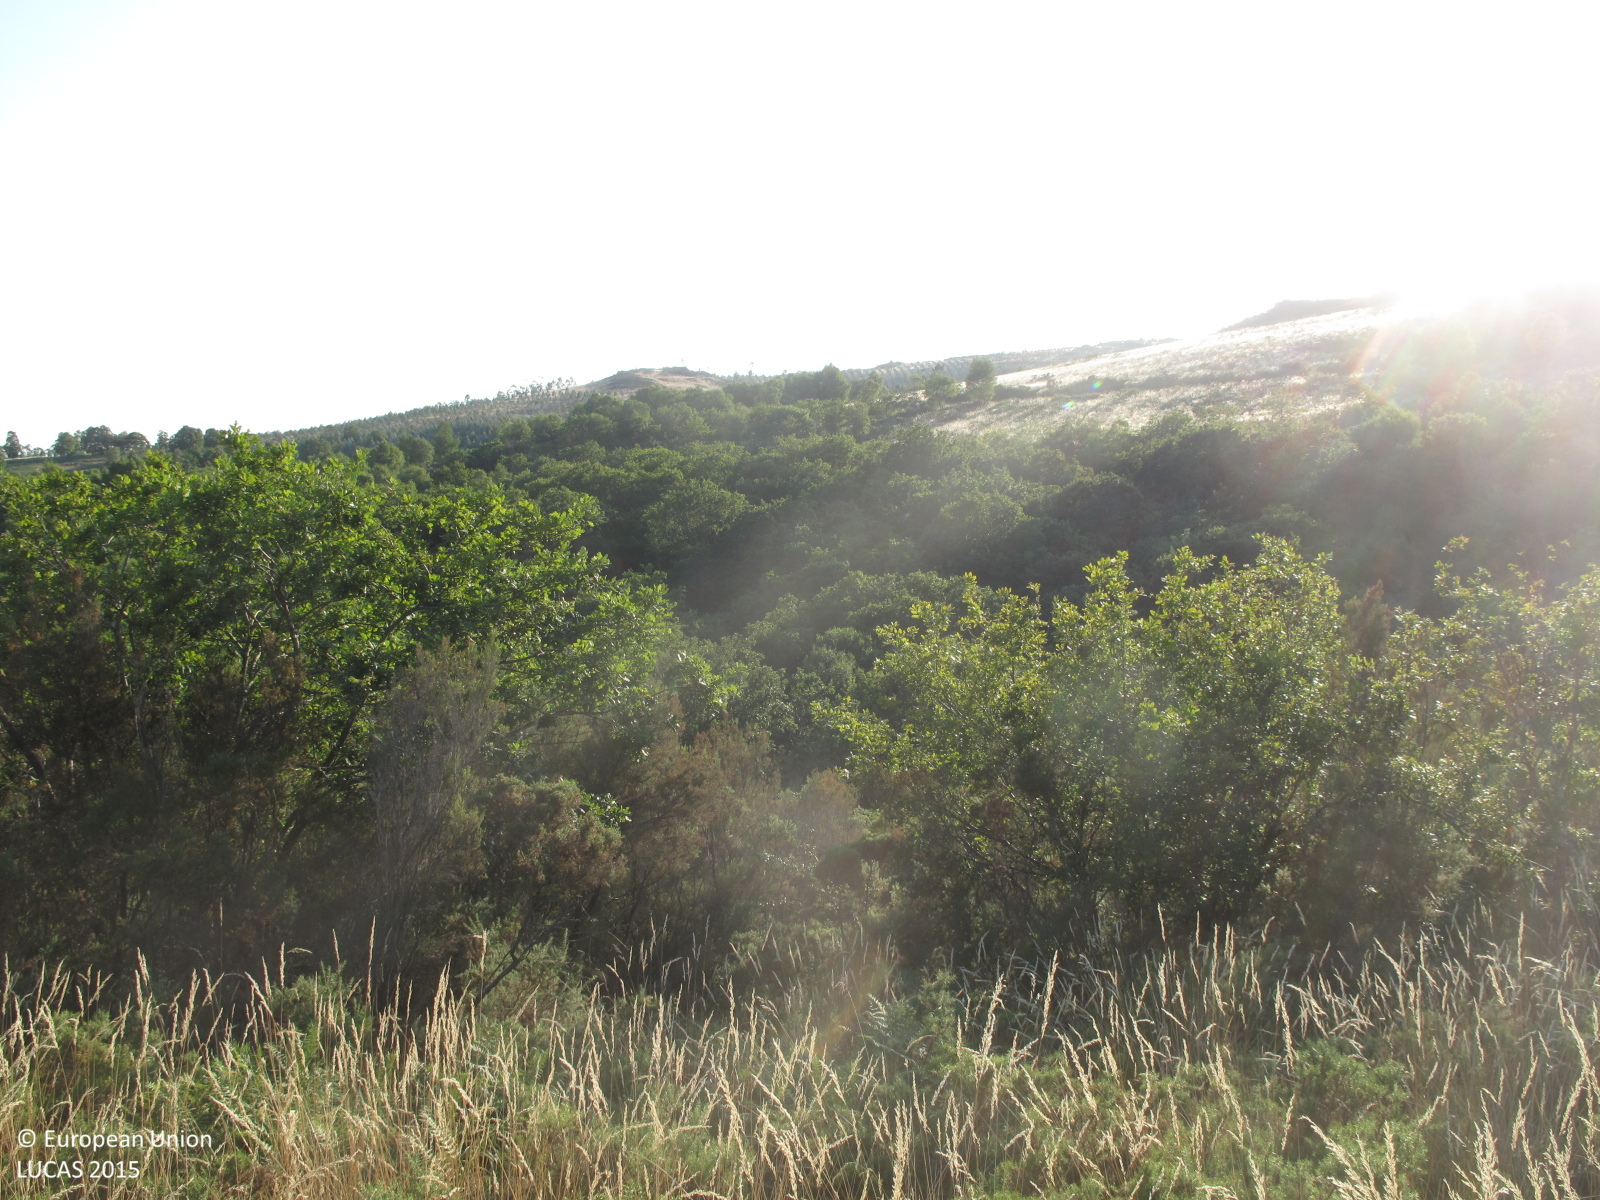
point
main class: Woodland
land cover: Broadleaved woodland
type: acidophilous oak and oak-birch forest
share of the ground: > 75 %
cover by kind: broadleaved forest trees 90 %, shrubs 10 %
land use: Semi-natural and natural areas not in use
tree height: > 5 m
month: July
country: ES
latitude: 43.4126
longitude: -7.9639
